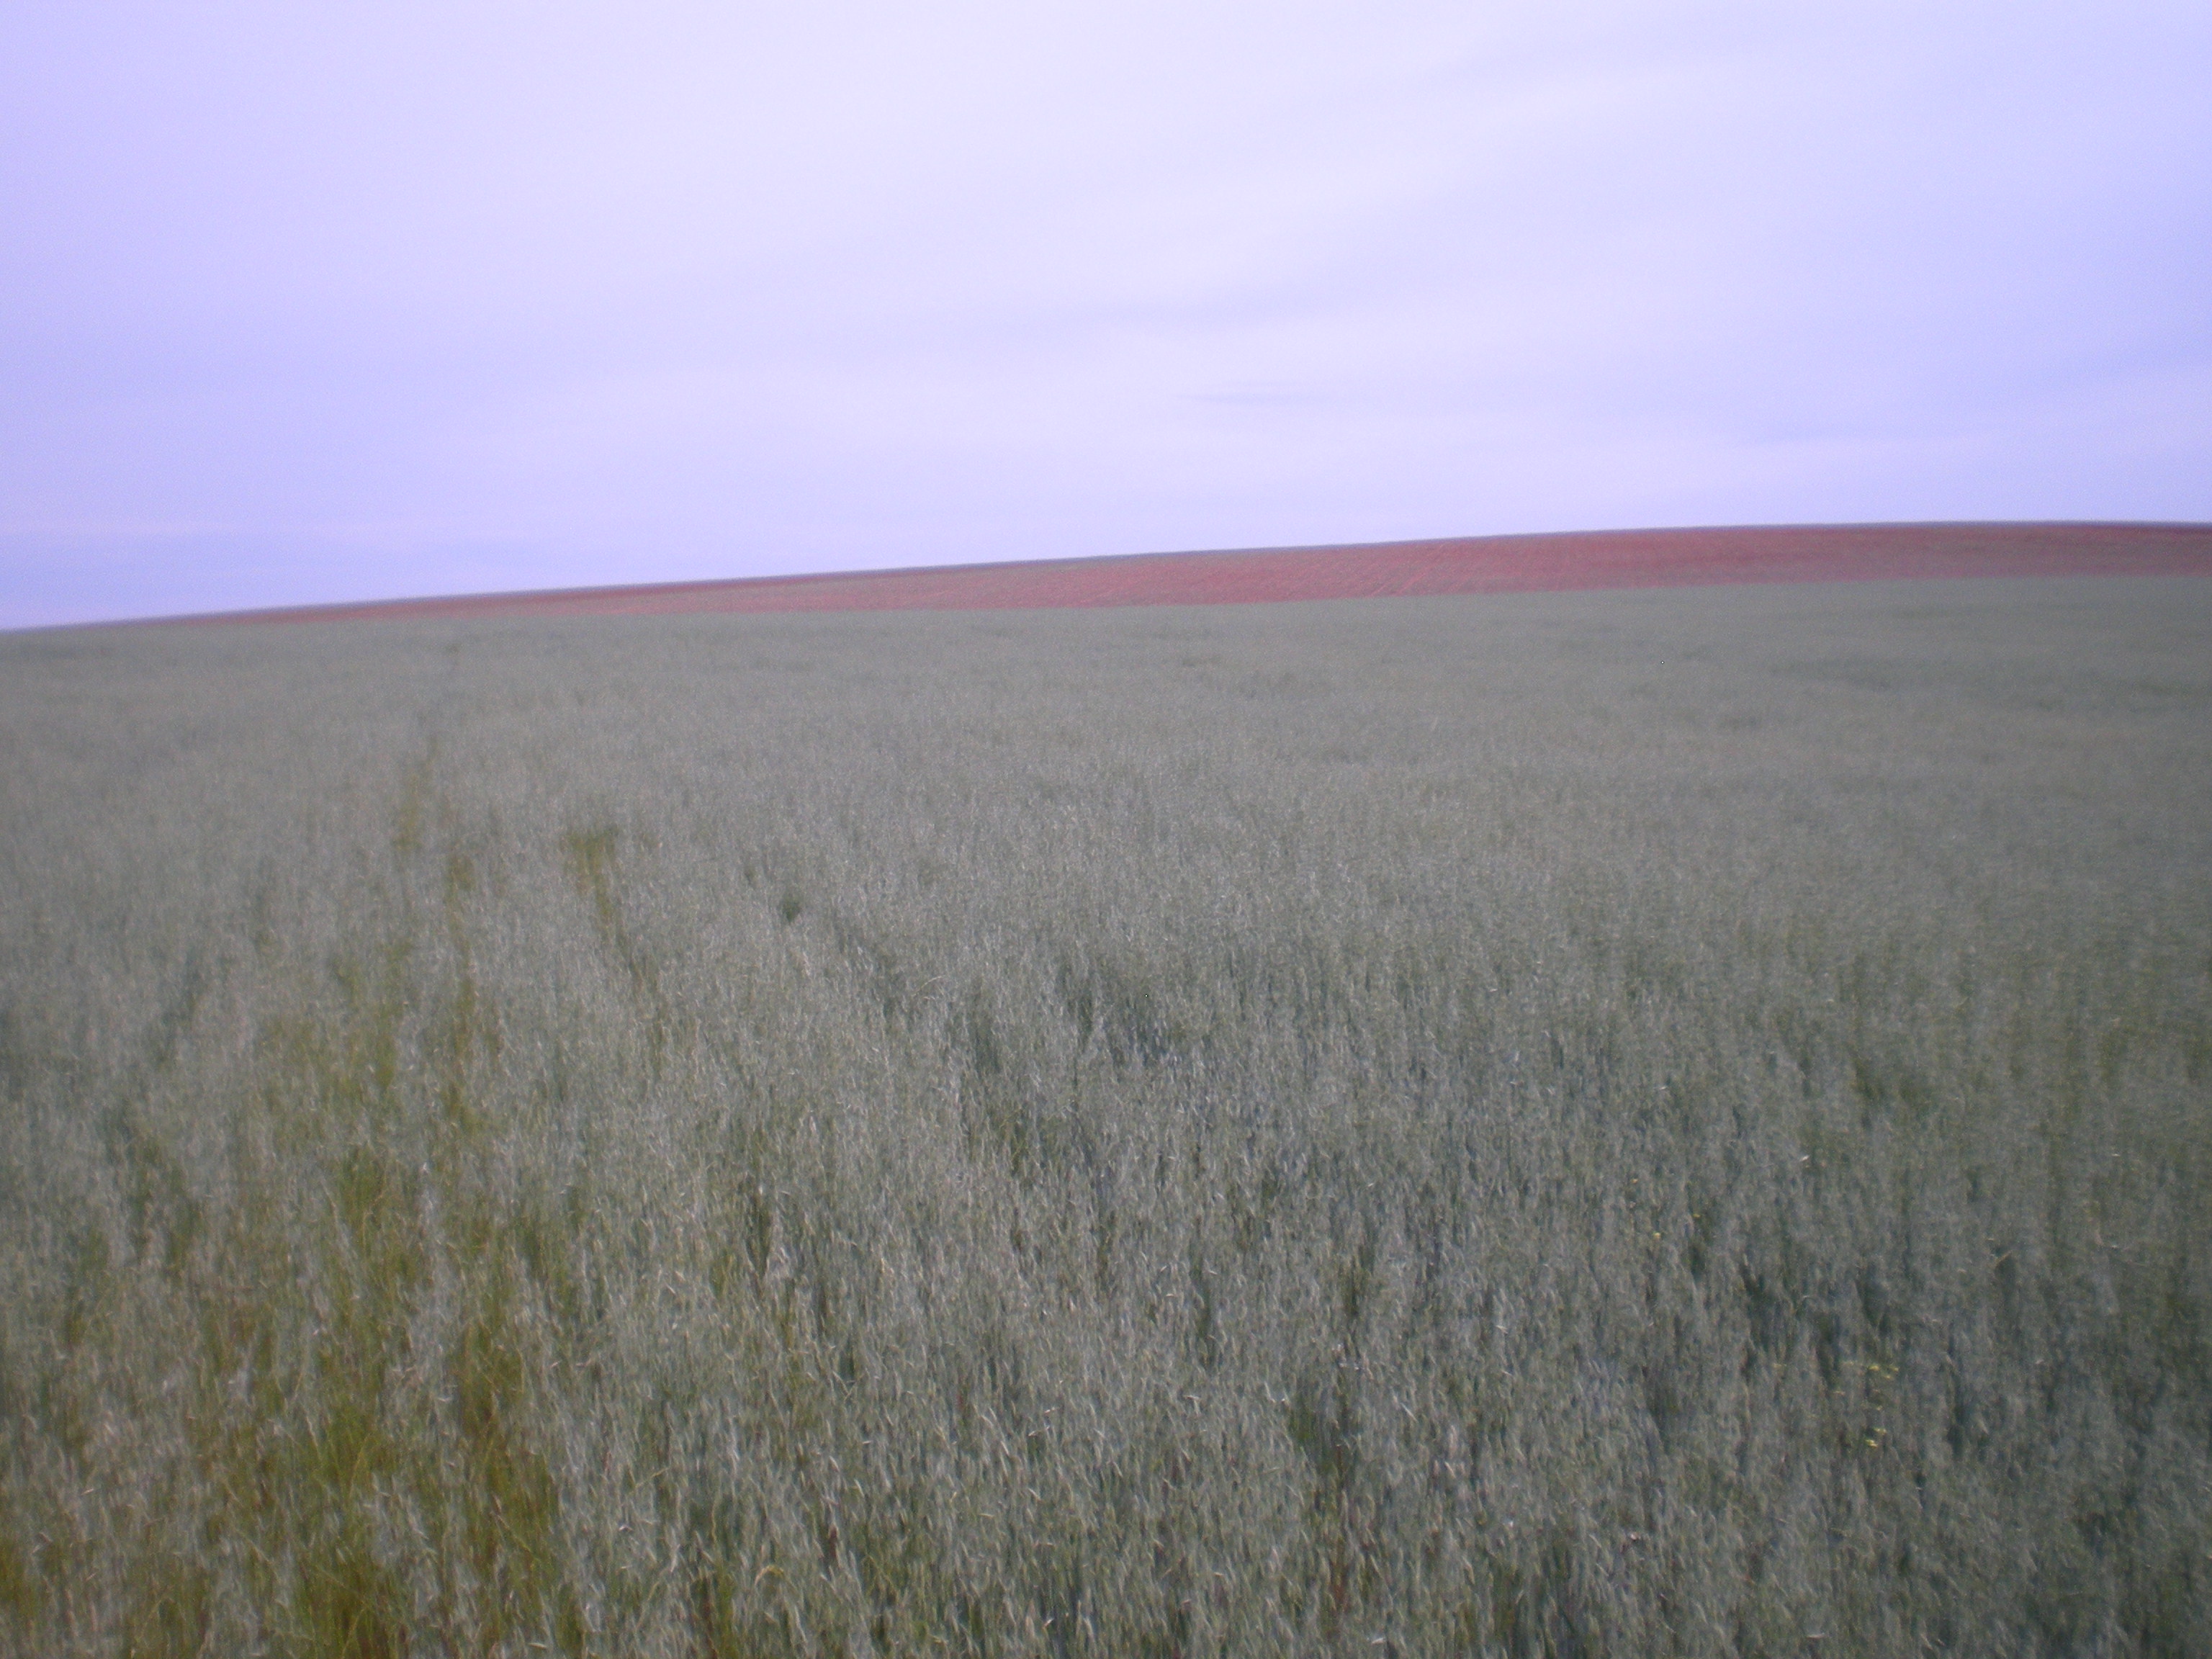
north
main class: Cropland
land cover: Oats
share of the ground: > 75 %
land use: Agriculture (excluding fallow land and kitchen gardens)
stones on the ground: 10 - 25 %
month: May
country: ES
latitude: 38.6468
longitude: -3.1396
